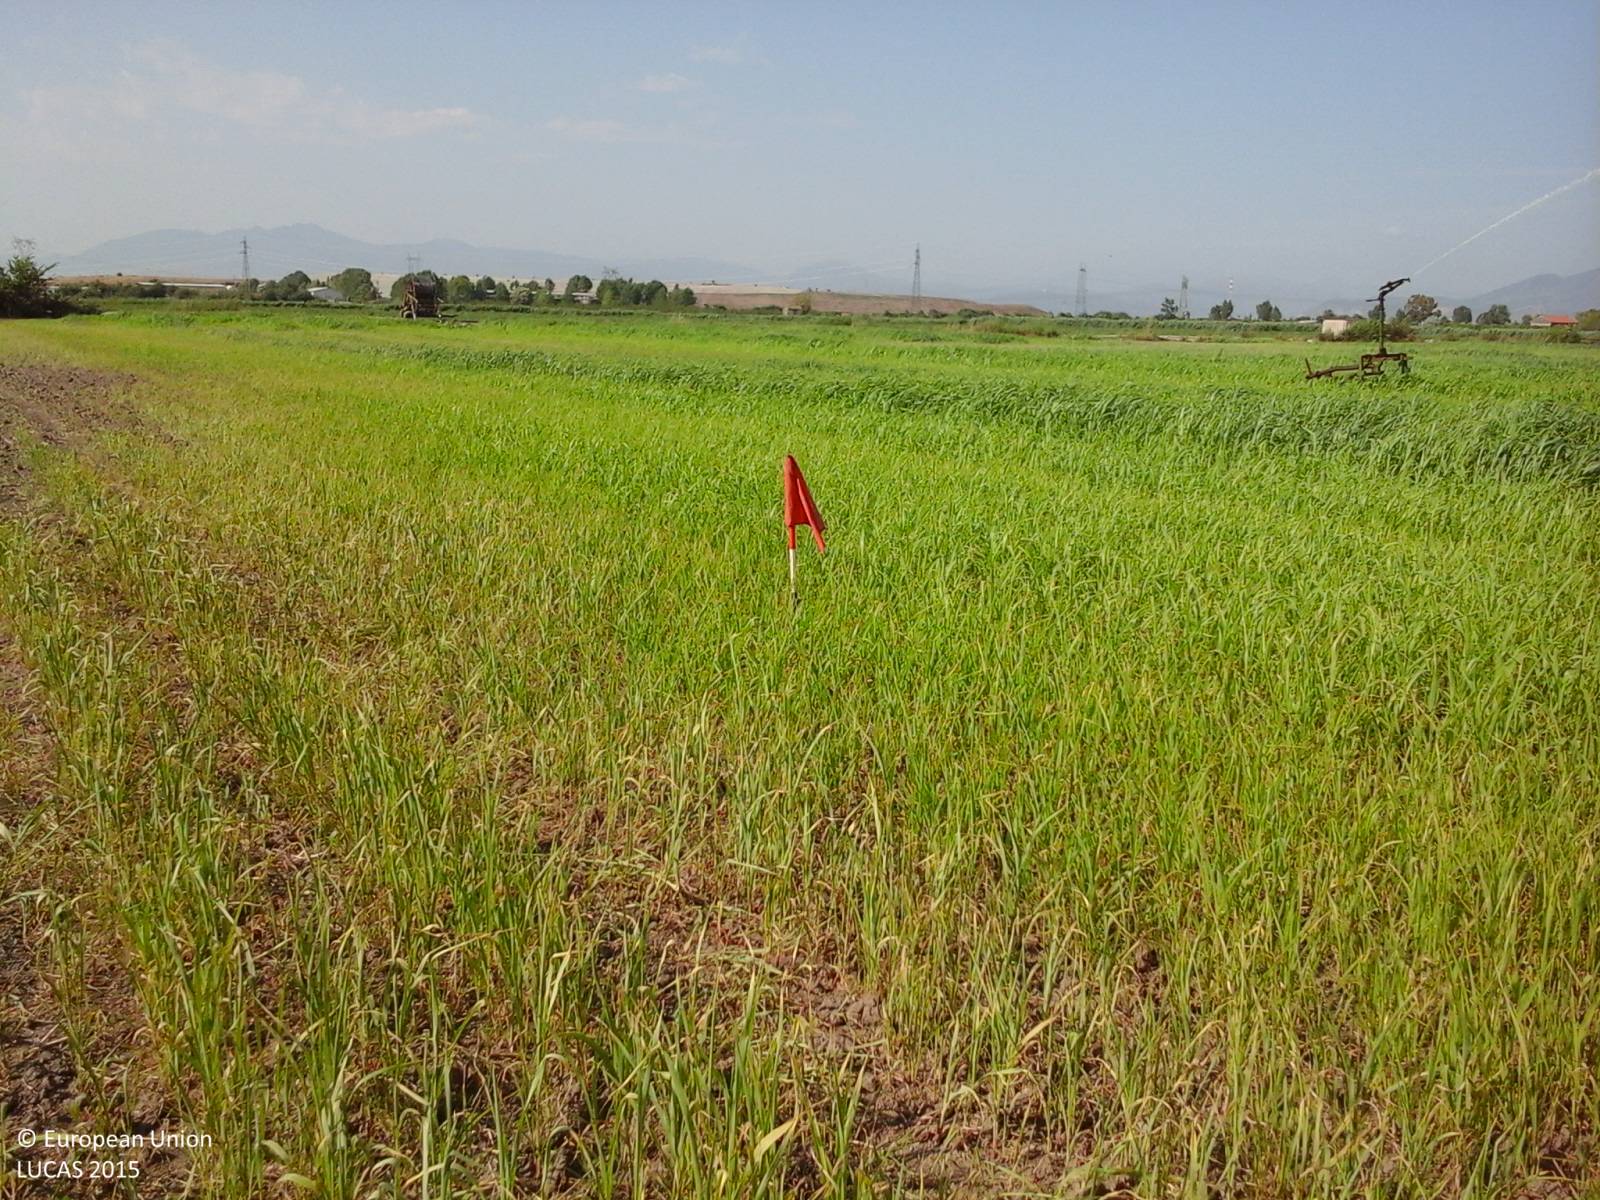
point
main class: Cropland
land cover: Other cereals
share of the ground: 50 - 75 %
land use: Agriculture (excluding fallow land and kitchen gardens)
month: July
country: IT
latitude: 41.0487
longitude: 14.1591
